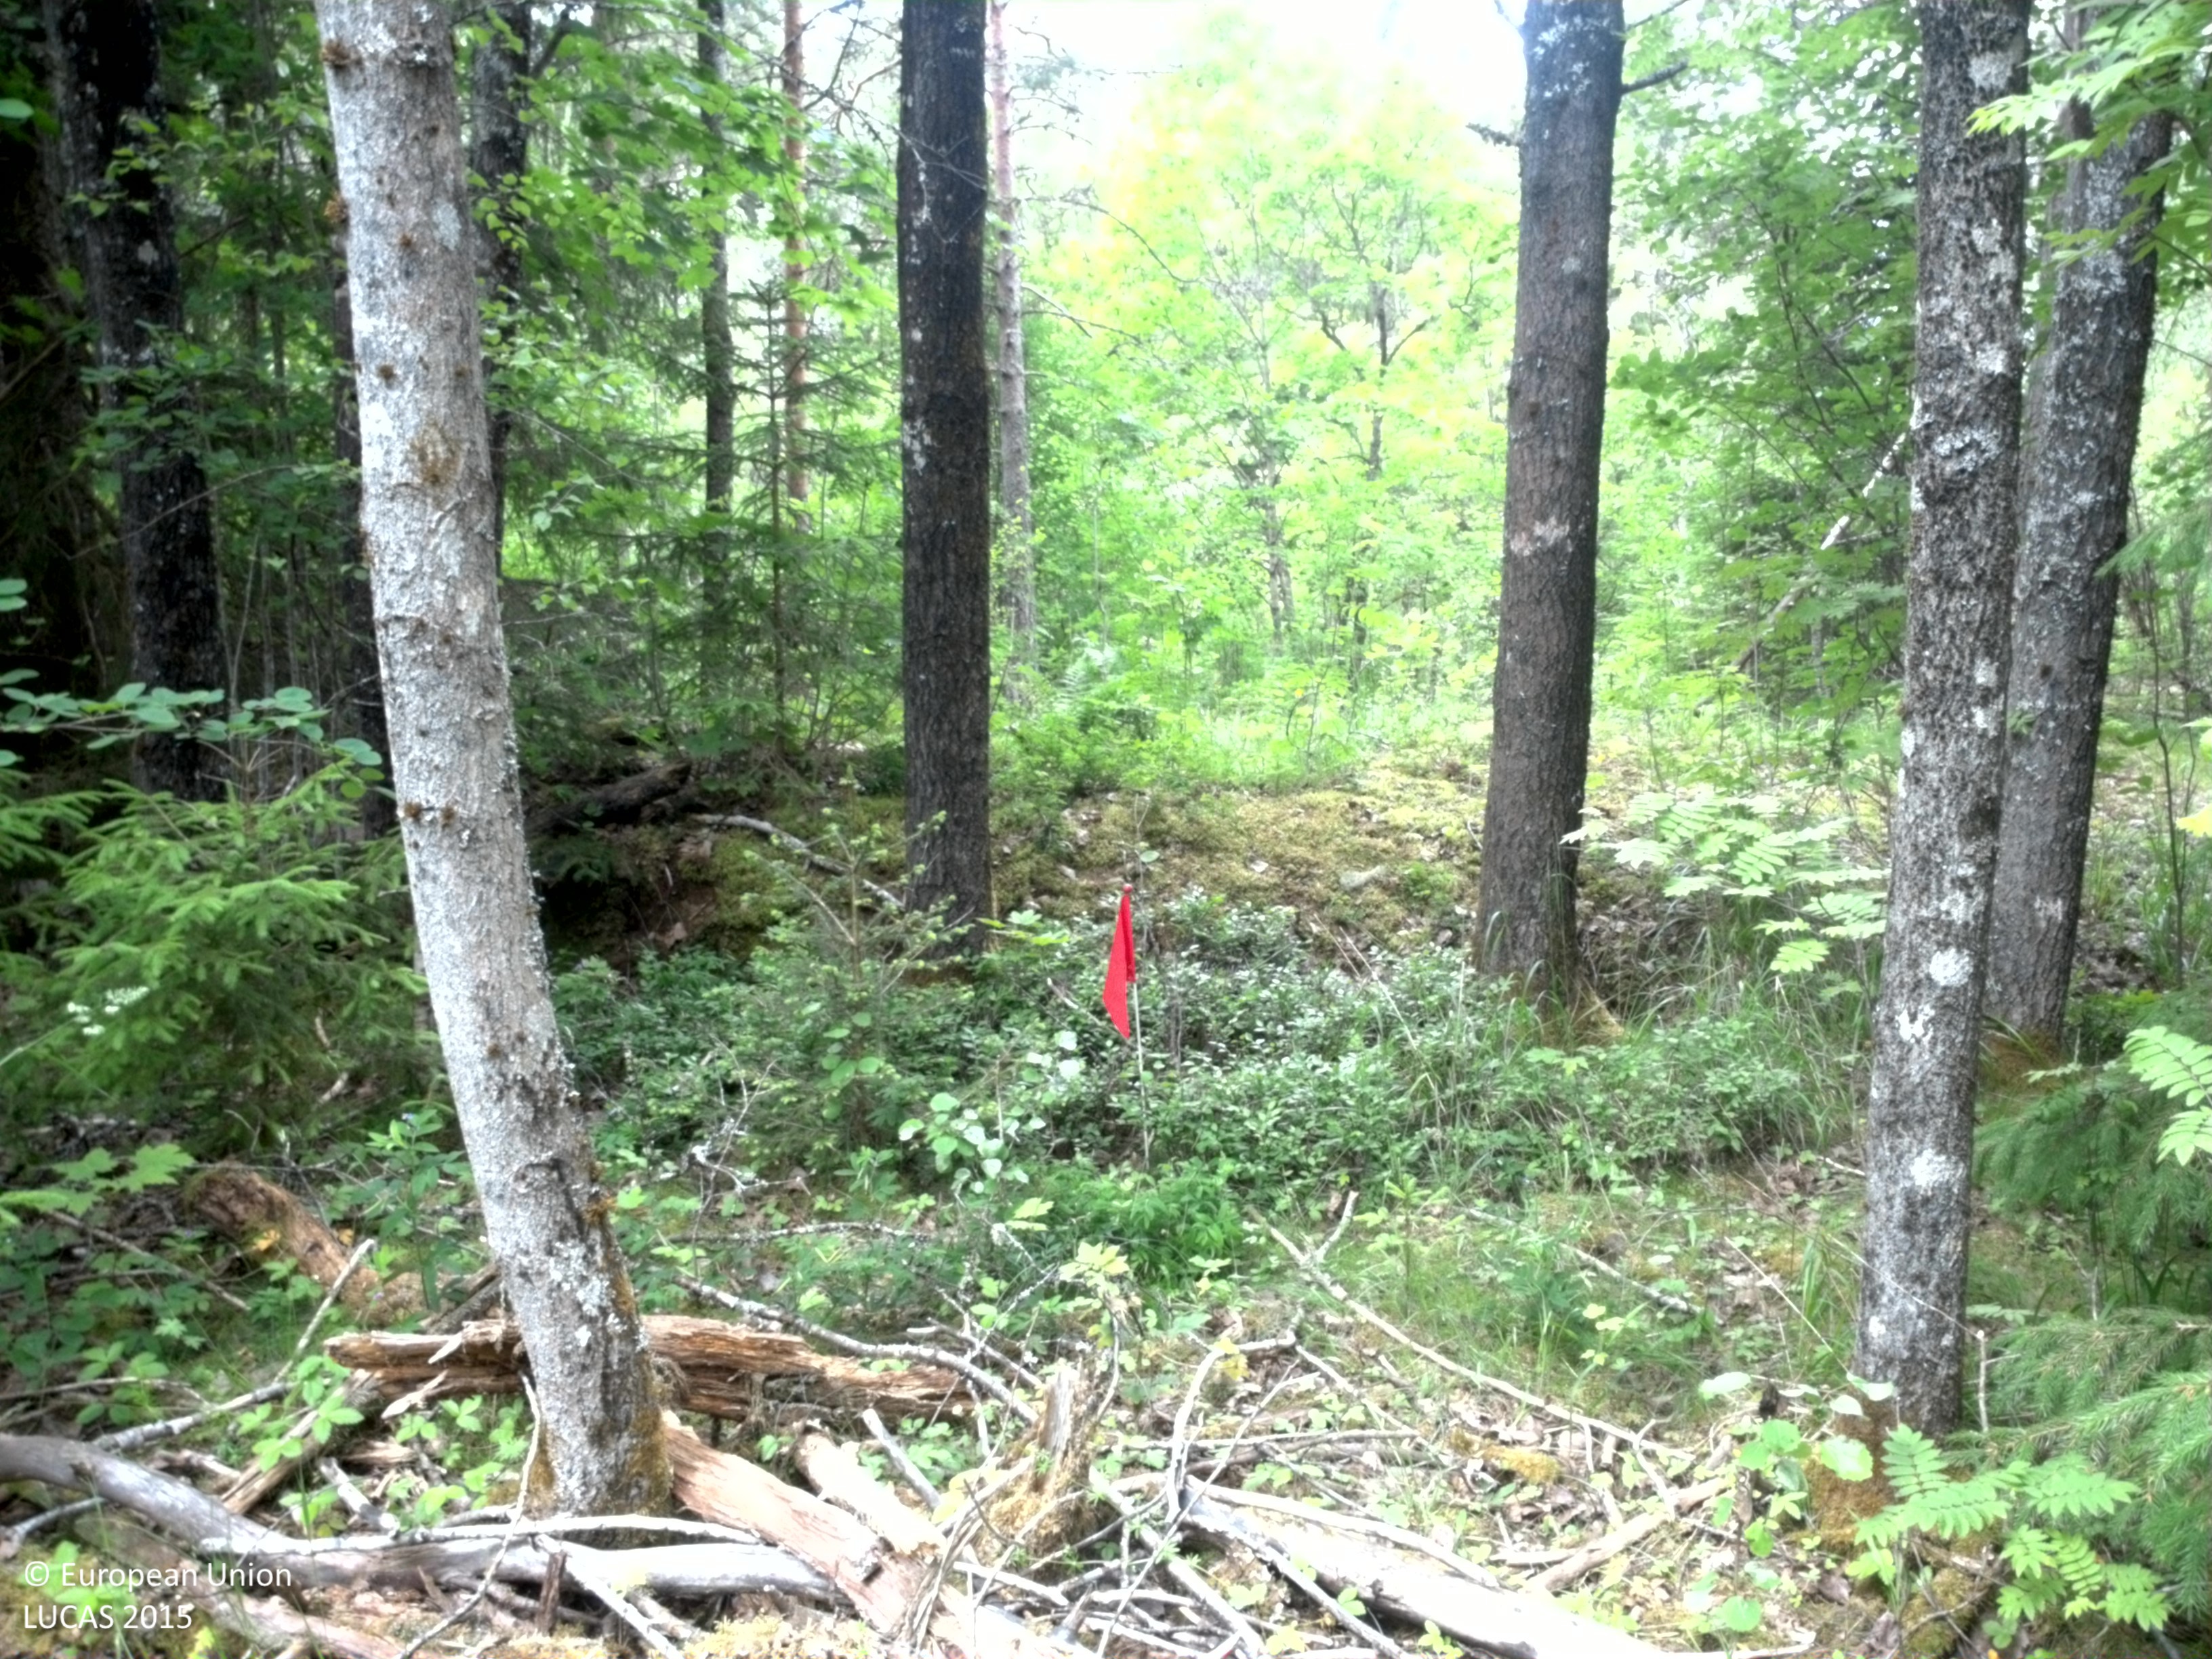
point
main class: Woodland
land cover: Broadleaved woodland
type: boreal forest
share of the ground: 25 - 50 %
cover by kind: herbaceous plants 45 %, broadleaved forest trees 35 %, shrubs 10 %, coniferous forest trees 5 %, lichens and mosses 5 %
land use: Semi-natural and natural areas not in use
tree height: > 5 m
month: June
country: SE
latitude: 59.7653
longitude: 12.3260
